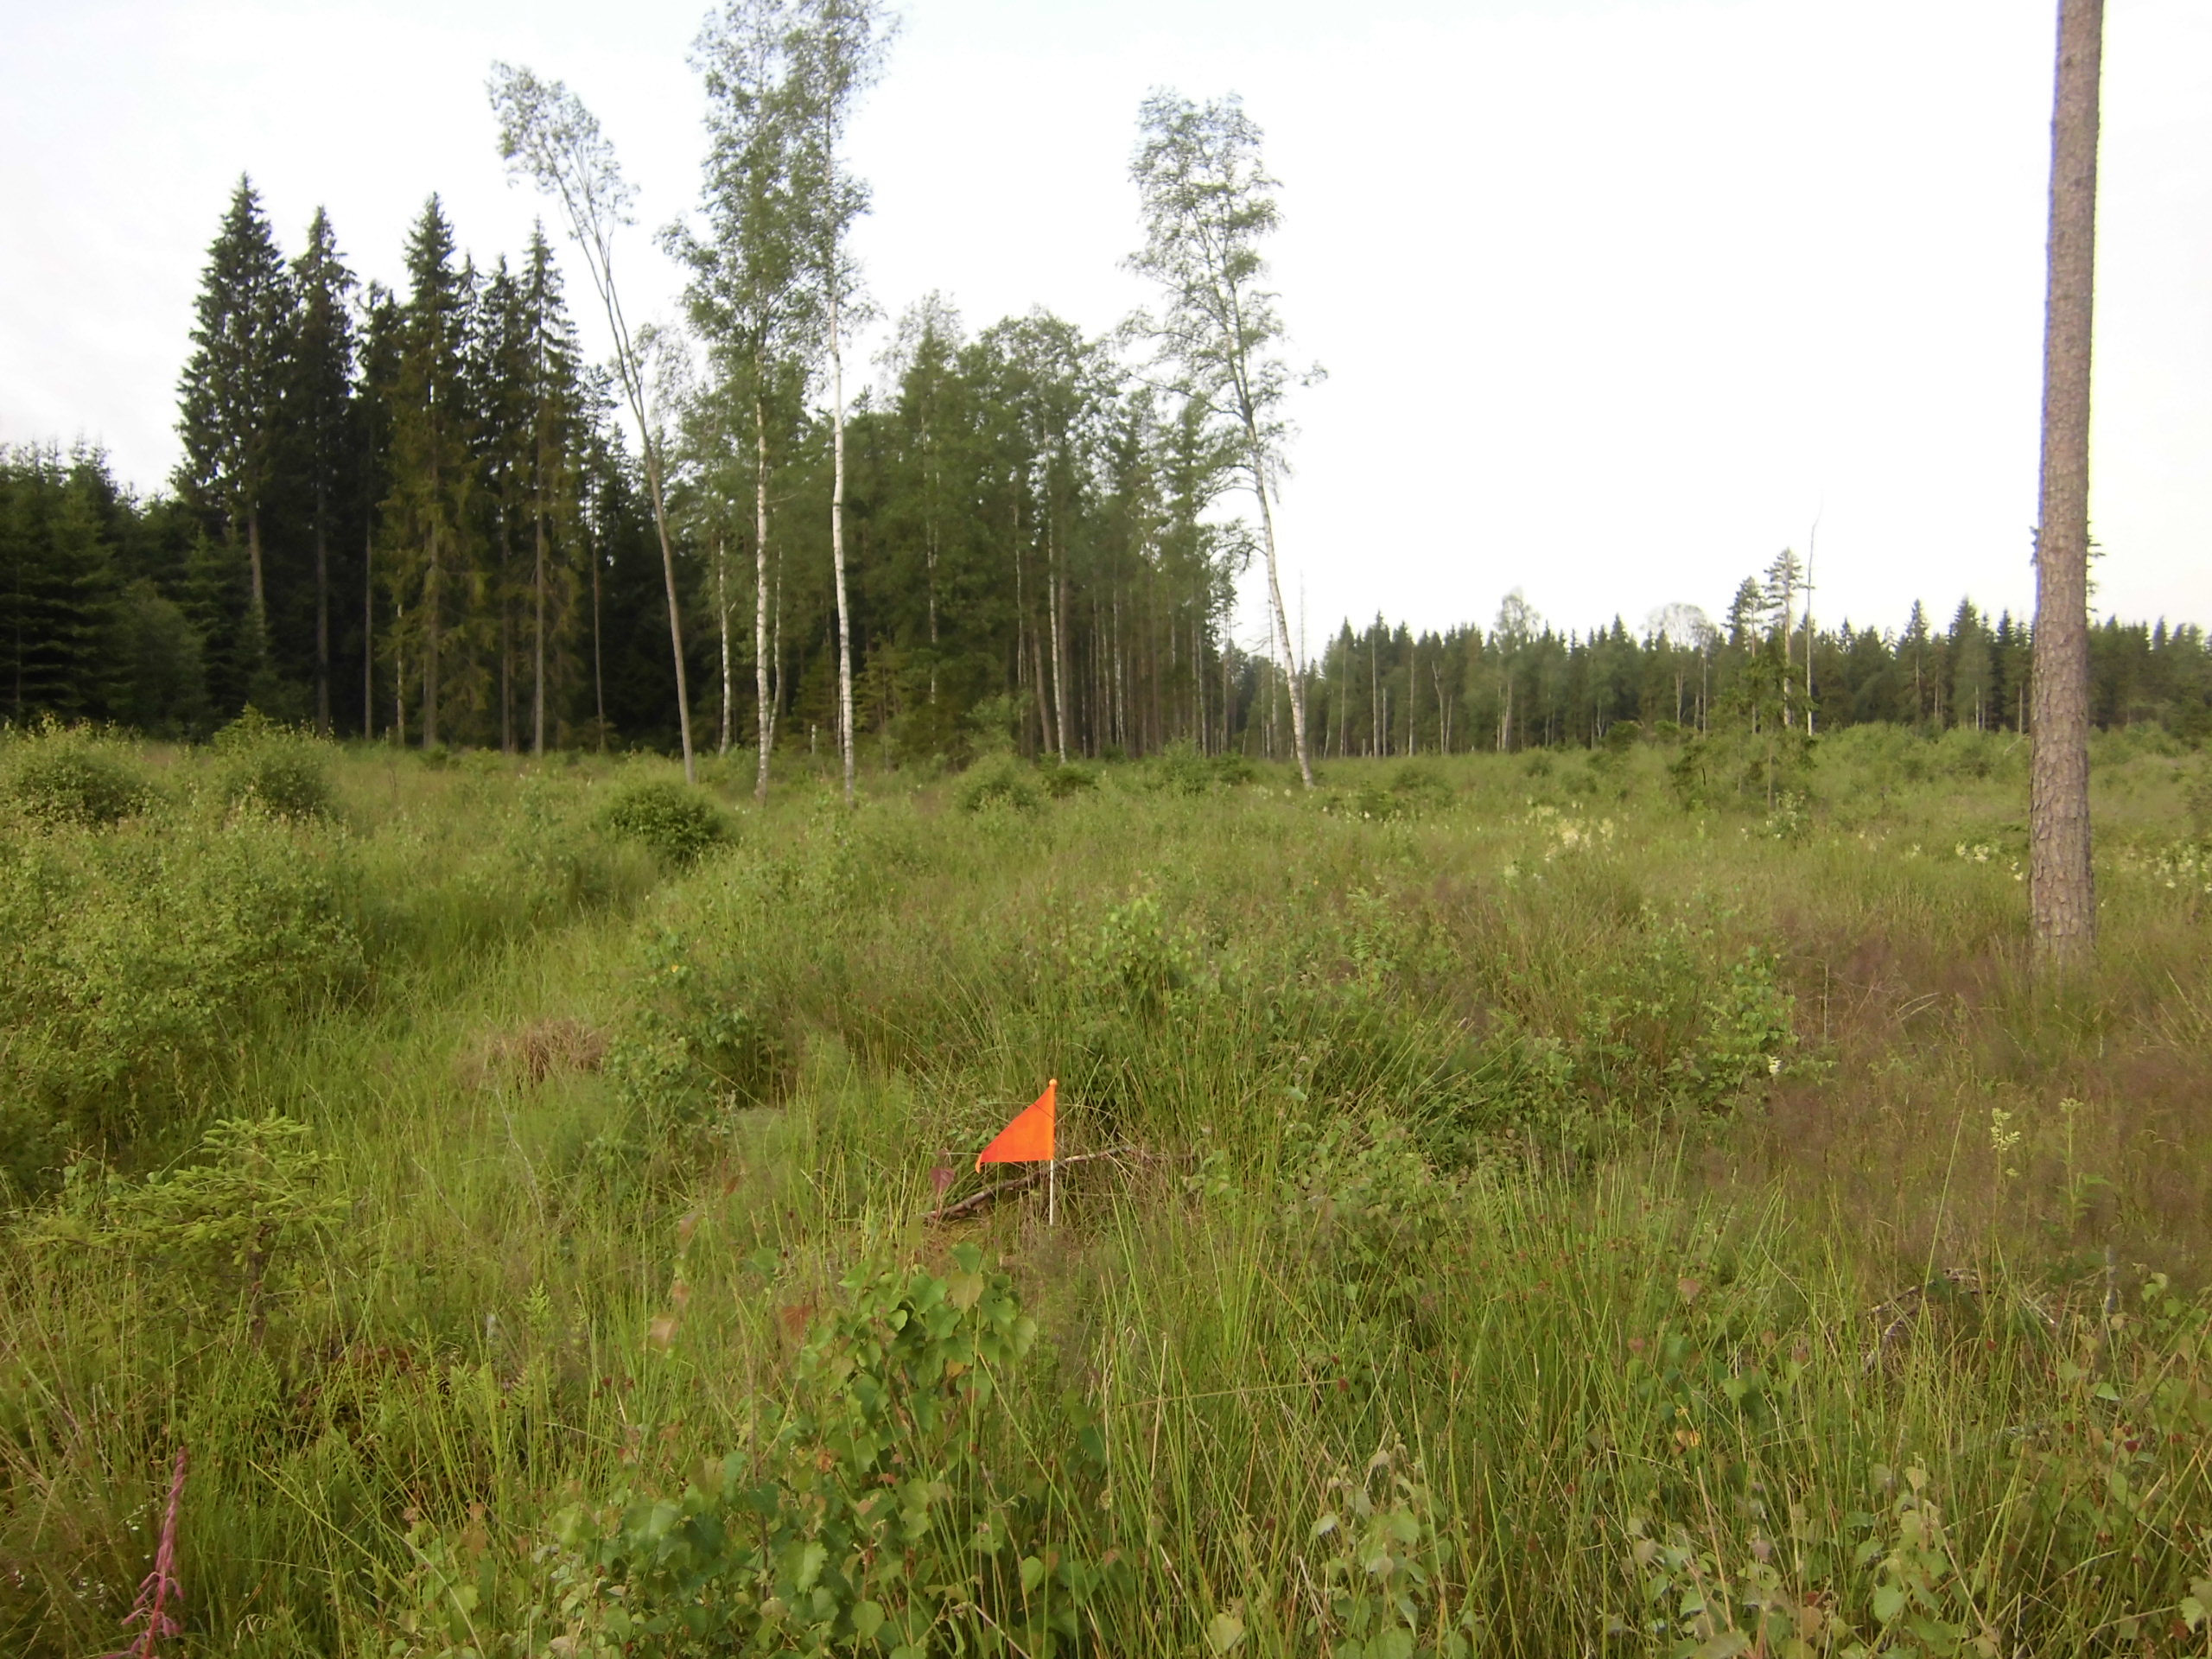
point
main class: Woodland
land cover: Pine dominated mixed woodland
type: boreal forest
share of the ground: 25 - 50 %
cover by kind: herbaceous plants 40 %, shrubs 25 %, broadleaved forest trees 15 %, coniferous forest trees 10 %, lichens and mosses 10 %
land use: Forestry
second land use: Amenities, museums, leisure
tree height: > 5 m
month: July
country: SE
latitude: 57.3937
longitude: 14.8380
